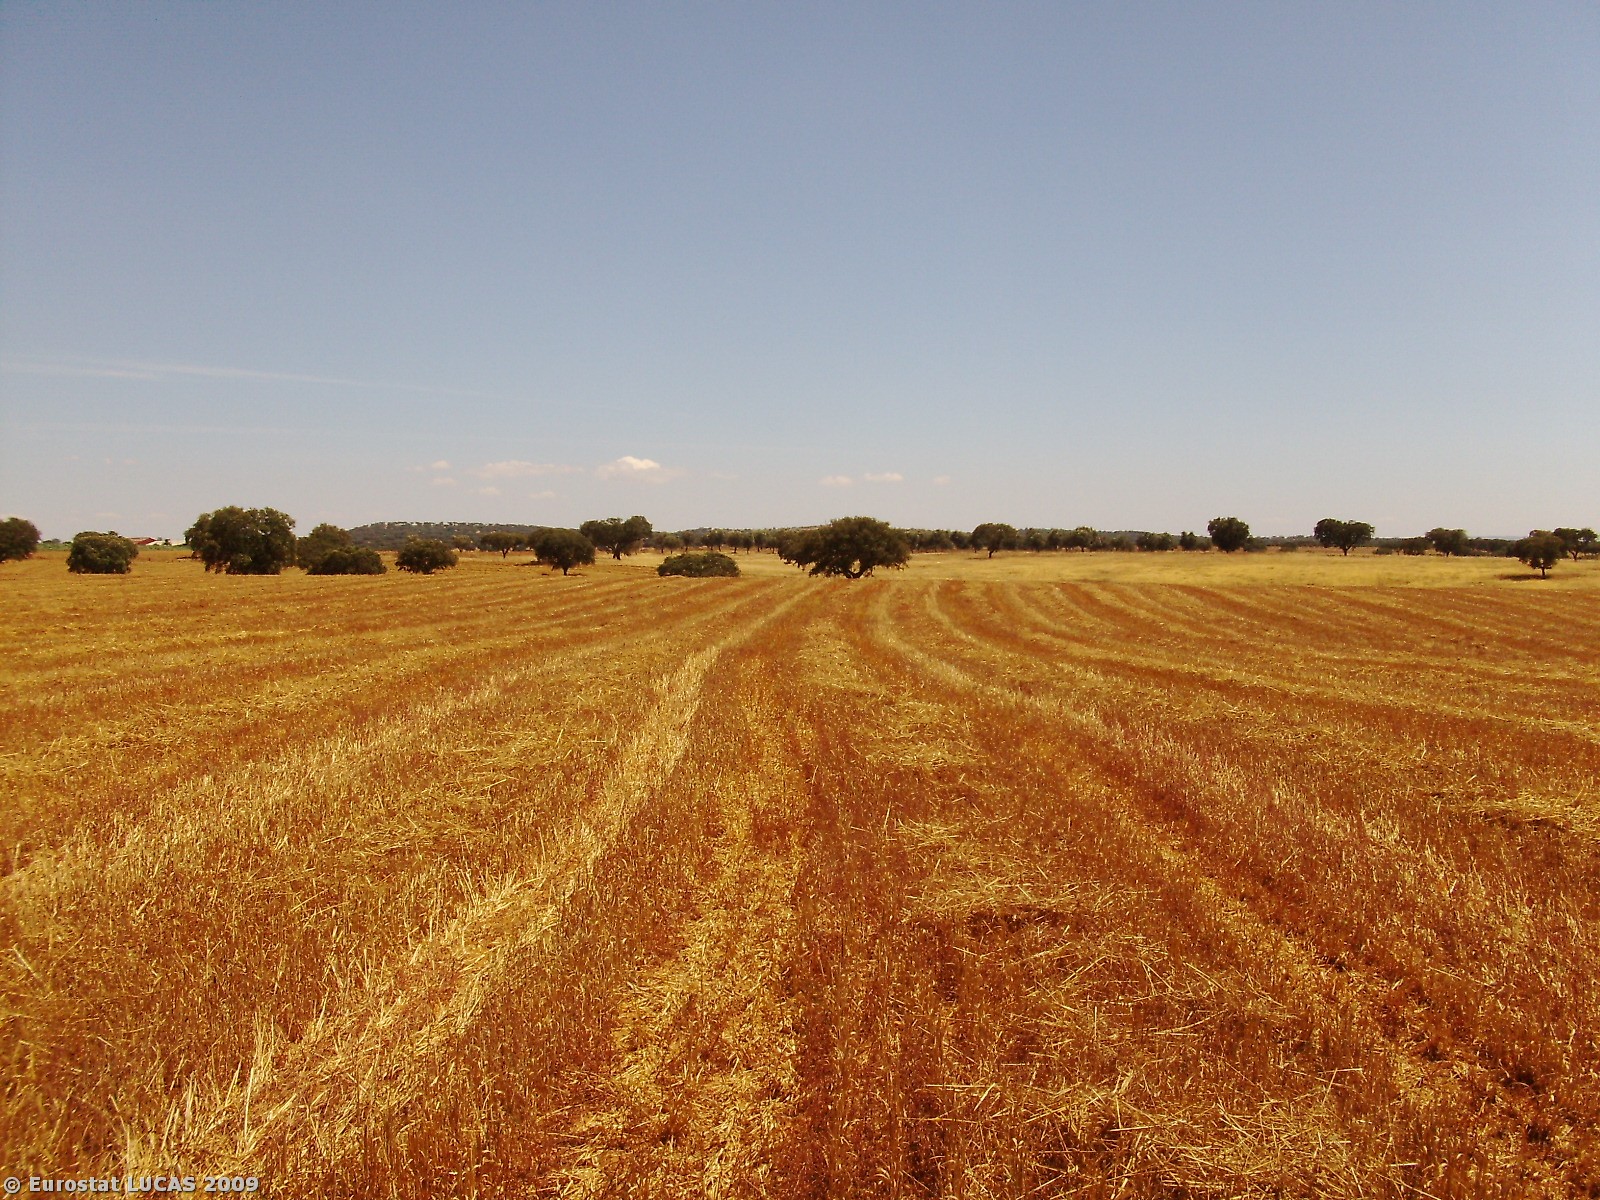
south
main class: Cropland
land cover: Oats
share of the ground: > 75 %
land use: Agriculture (excluding fallow land and kitchen gardens)
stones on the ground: 10 - 25 %
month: July
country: PT
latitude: 37.8410
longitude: -8.3189
